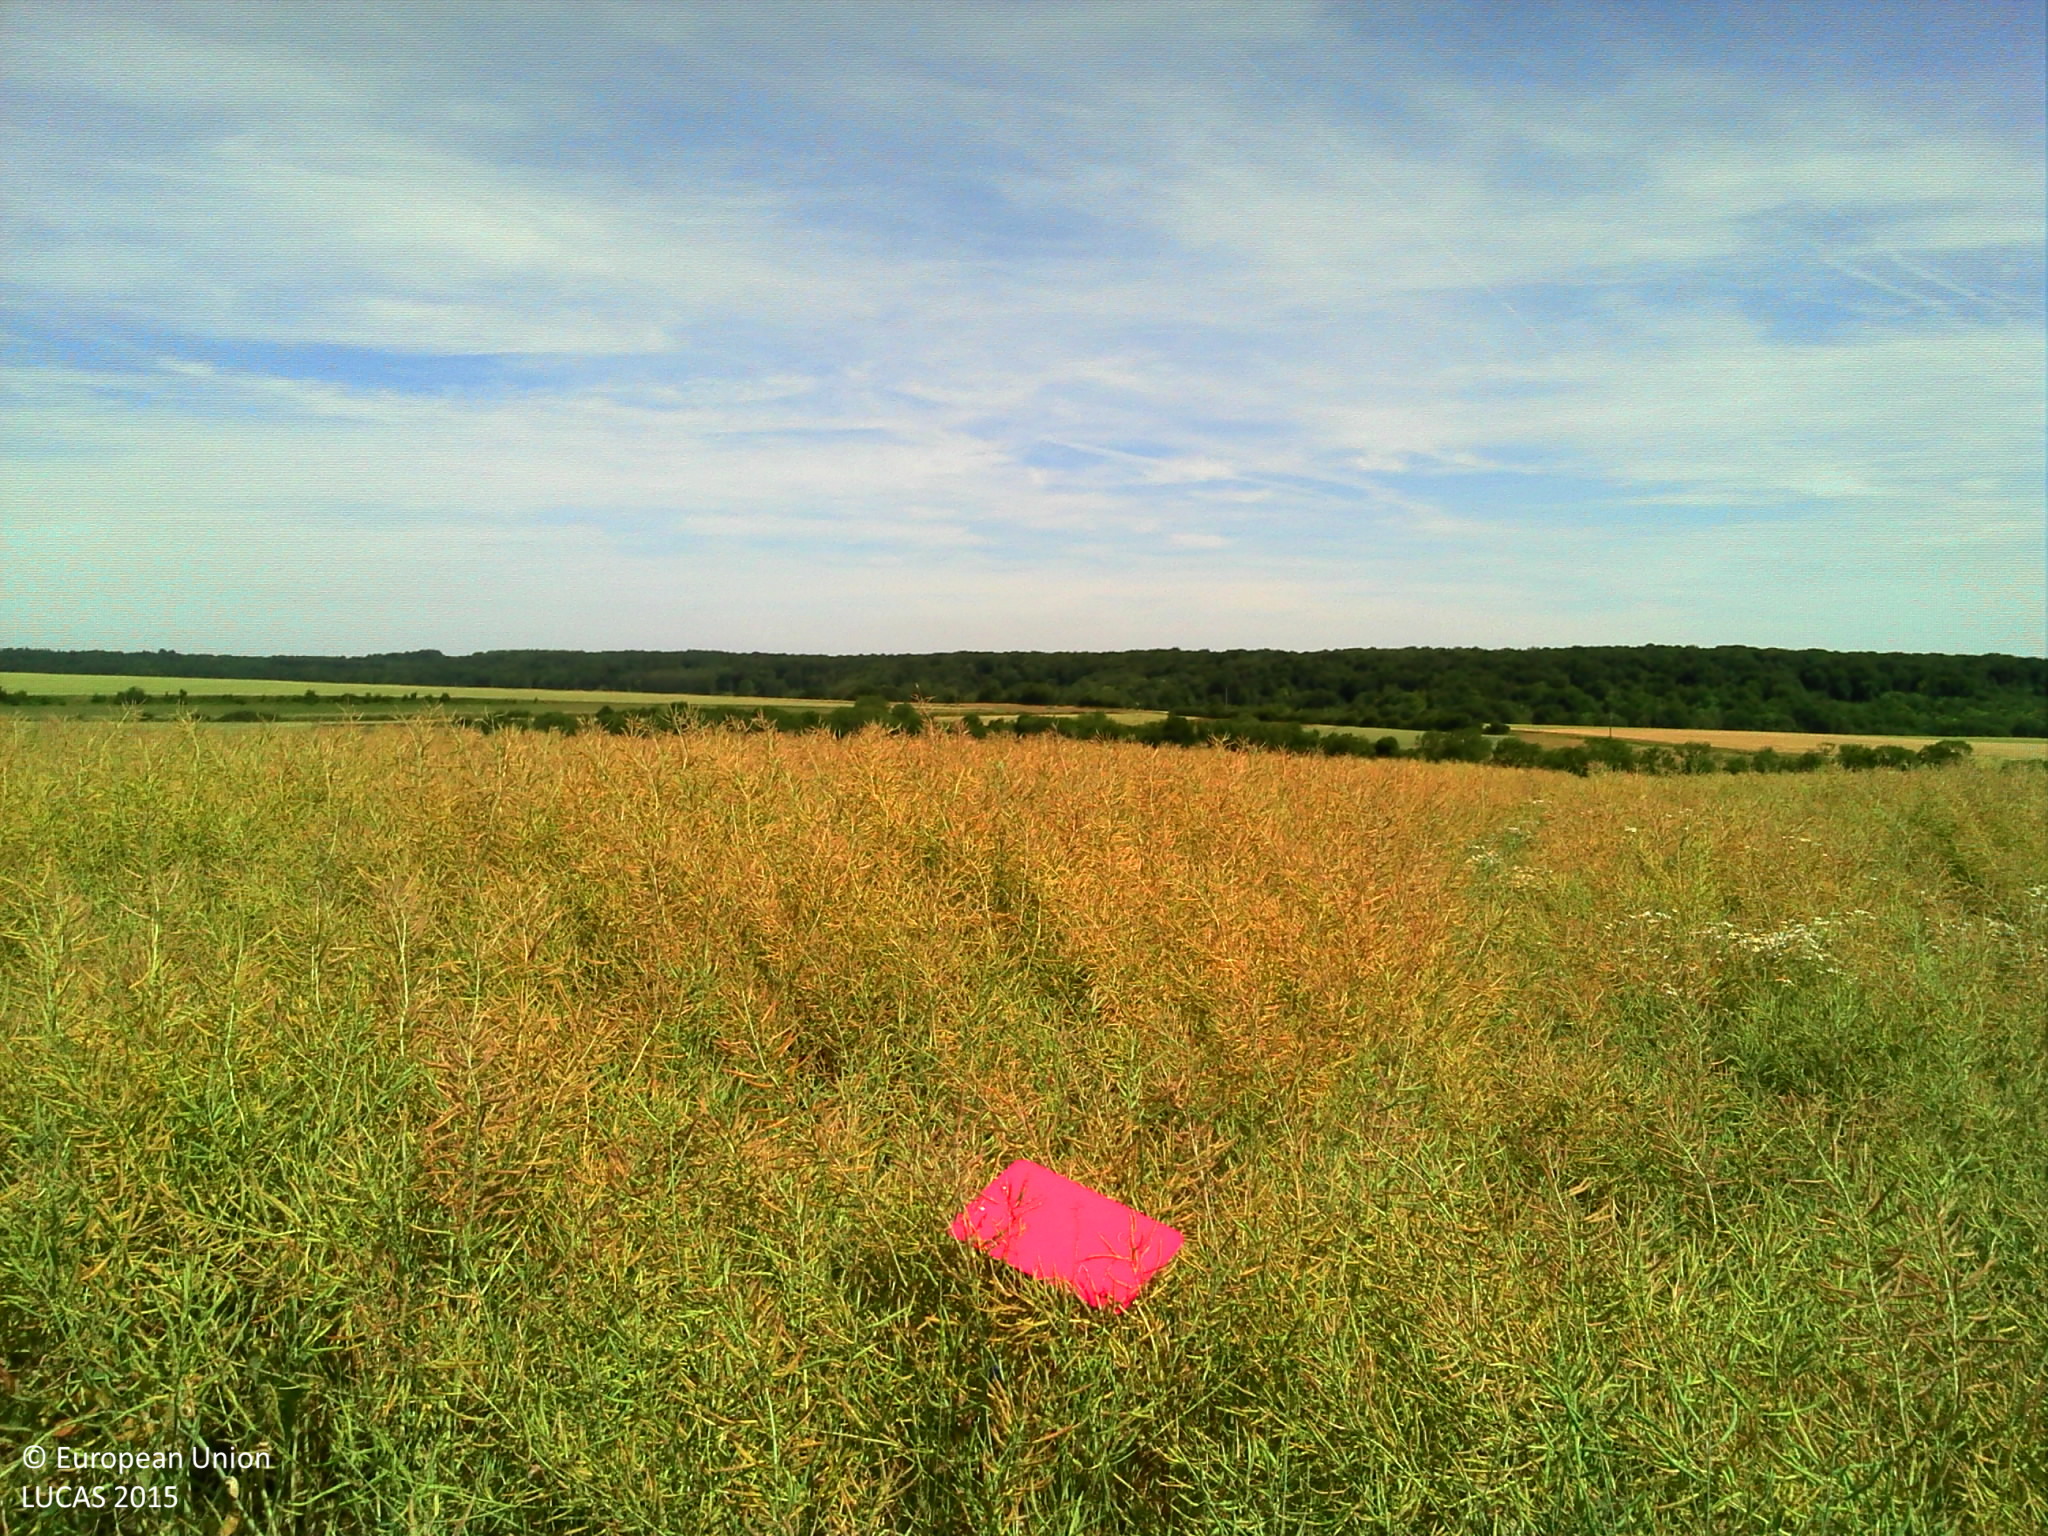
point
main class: Cropland
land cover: Rape and turnip rape
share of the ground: > 75 %
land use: Agriculture (excluding fallow land and kitchen gardens)
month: June
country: FR
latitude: 49.4936
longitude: 2.3523
